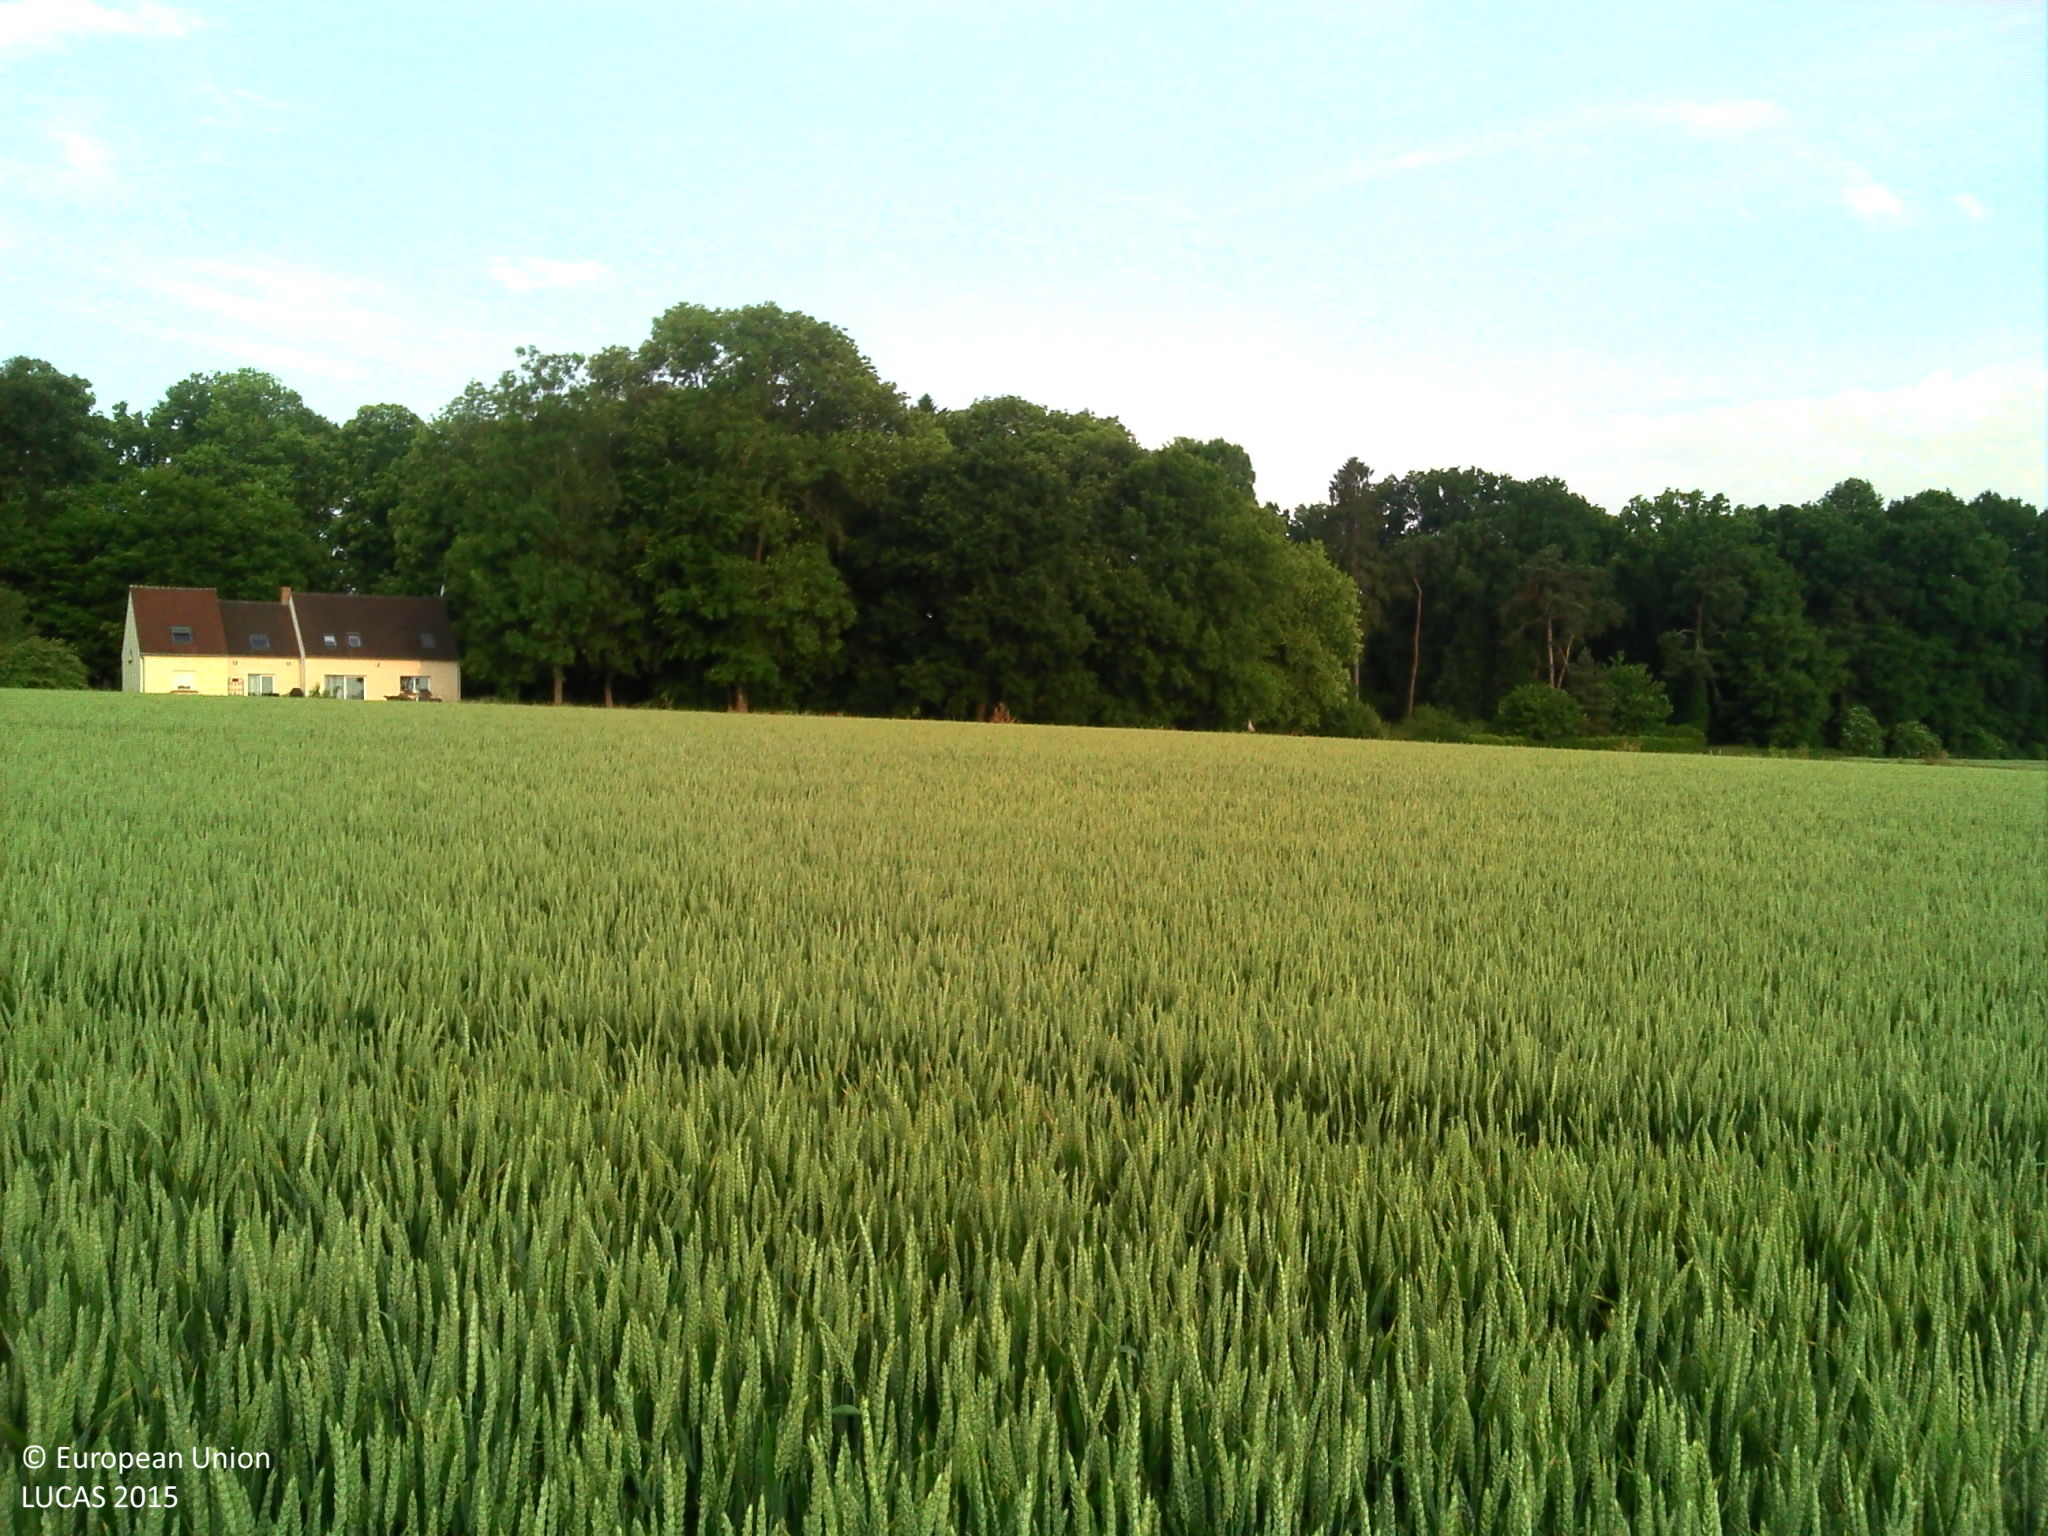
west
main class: Cropland
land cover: Common wheat
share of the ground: > 75 %
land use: Agriculture (excluding fallow land and kitchen gardens)
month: June
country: FR
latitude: 49.4886
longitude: 2.8250
